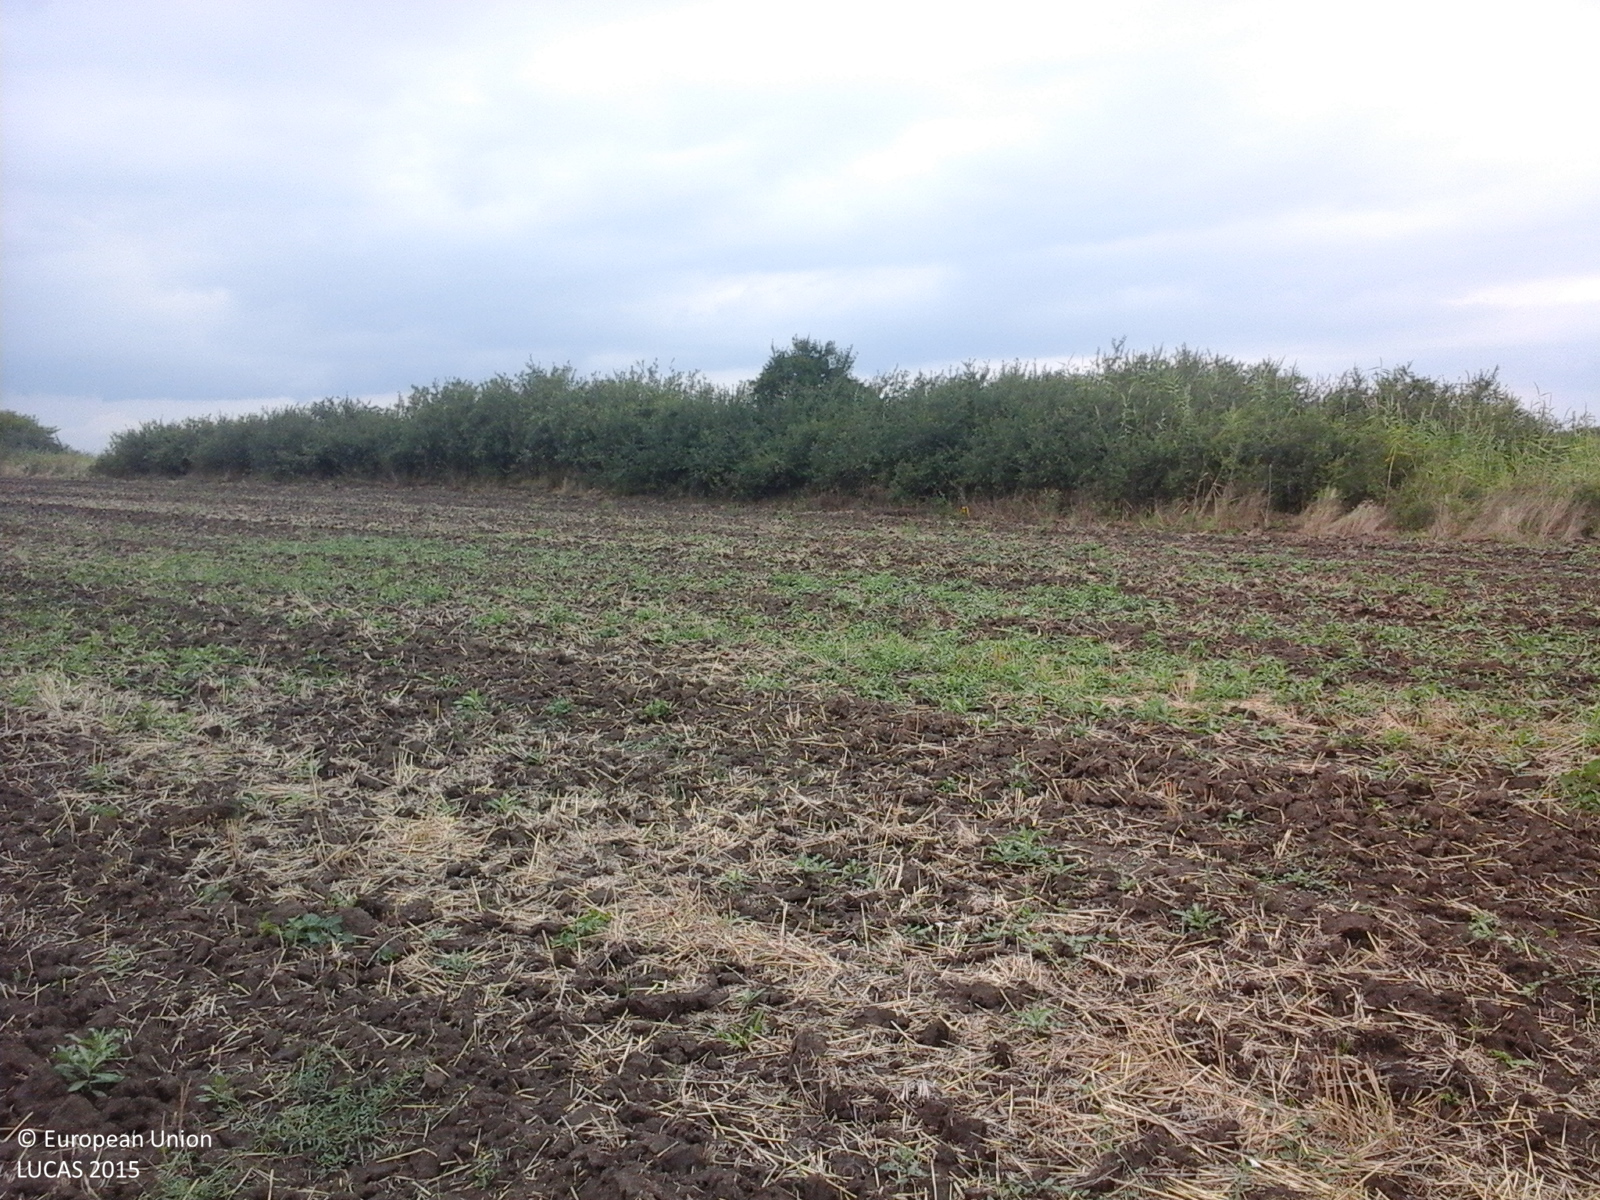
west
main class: Cropland
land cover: Common wheat
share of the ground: < 10 %
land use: Agriculture (excluding fallow land and kitchen gardens)
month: August
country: RO
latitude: 46.0630
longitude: 20.5606
